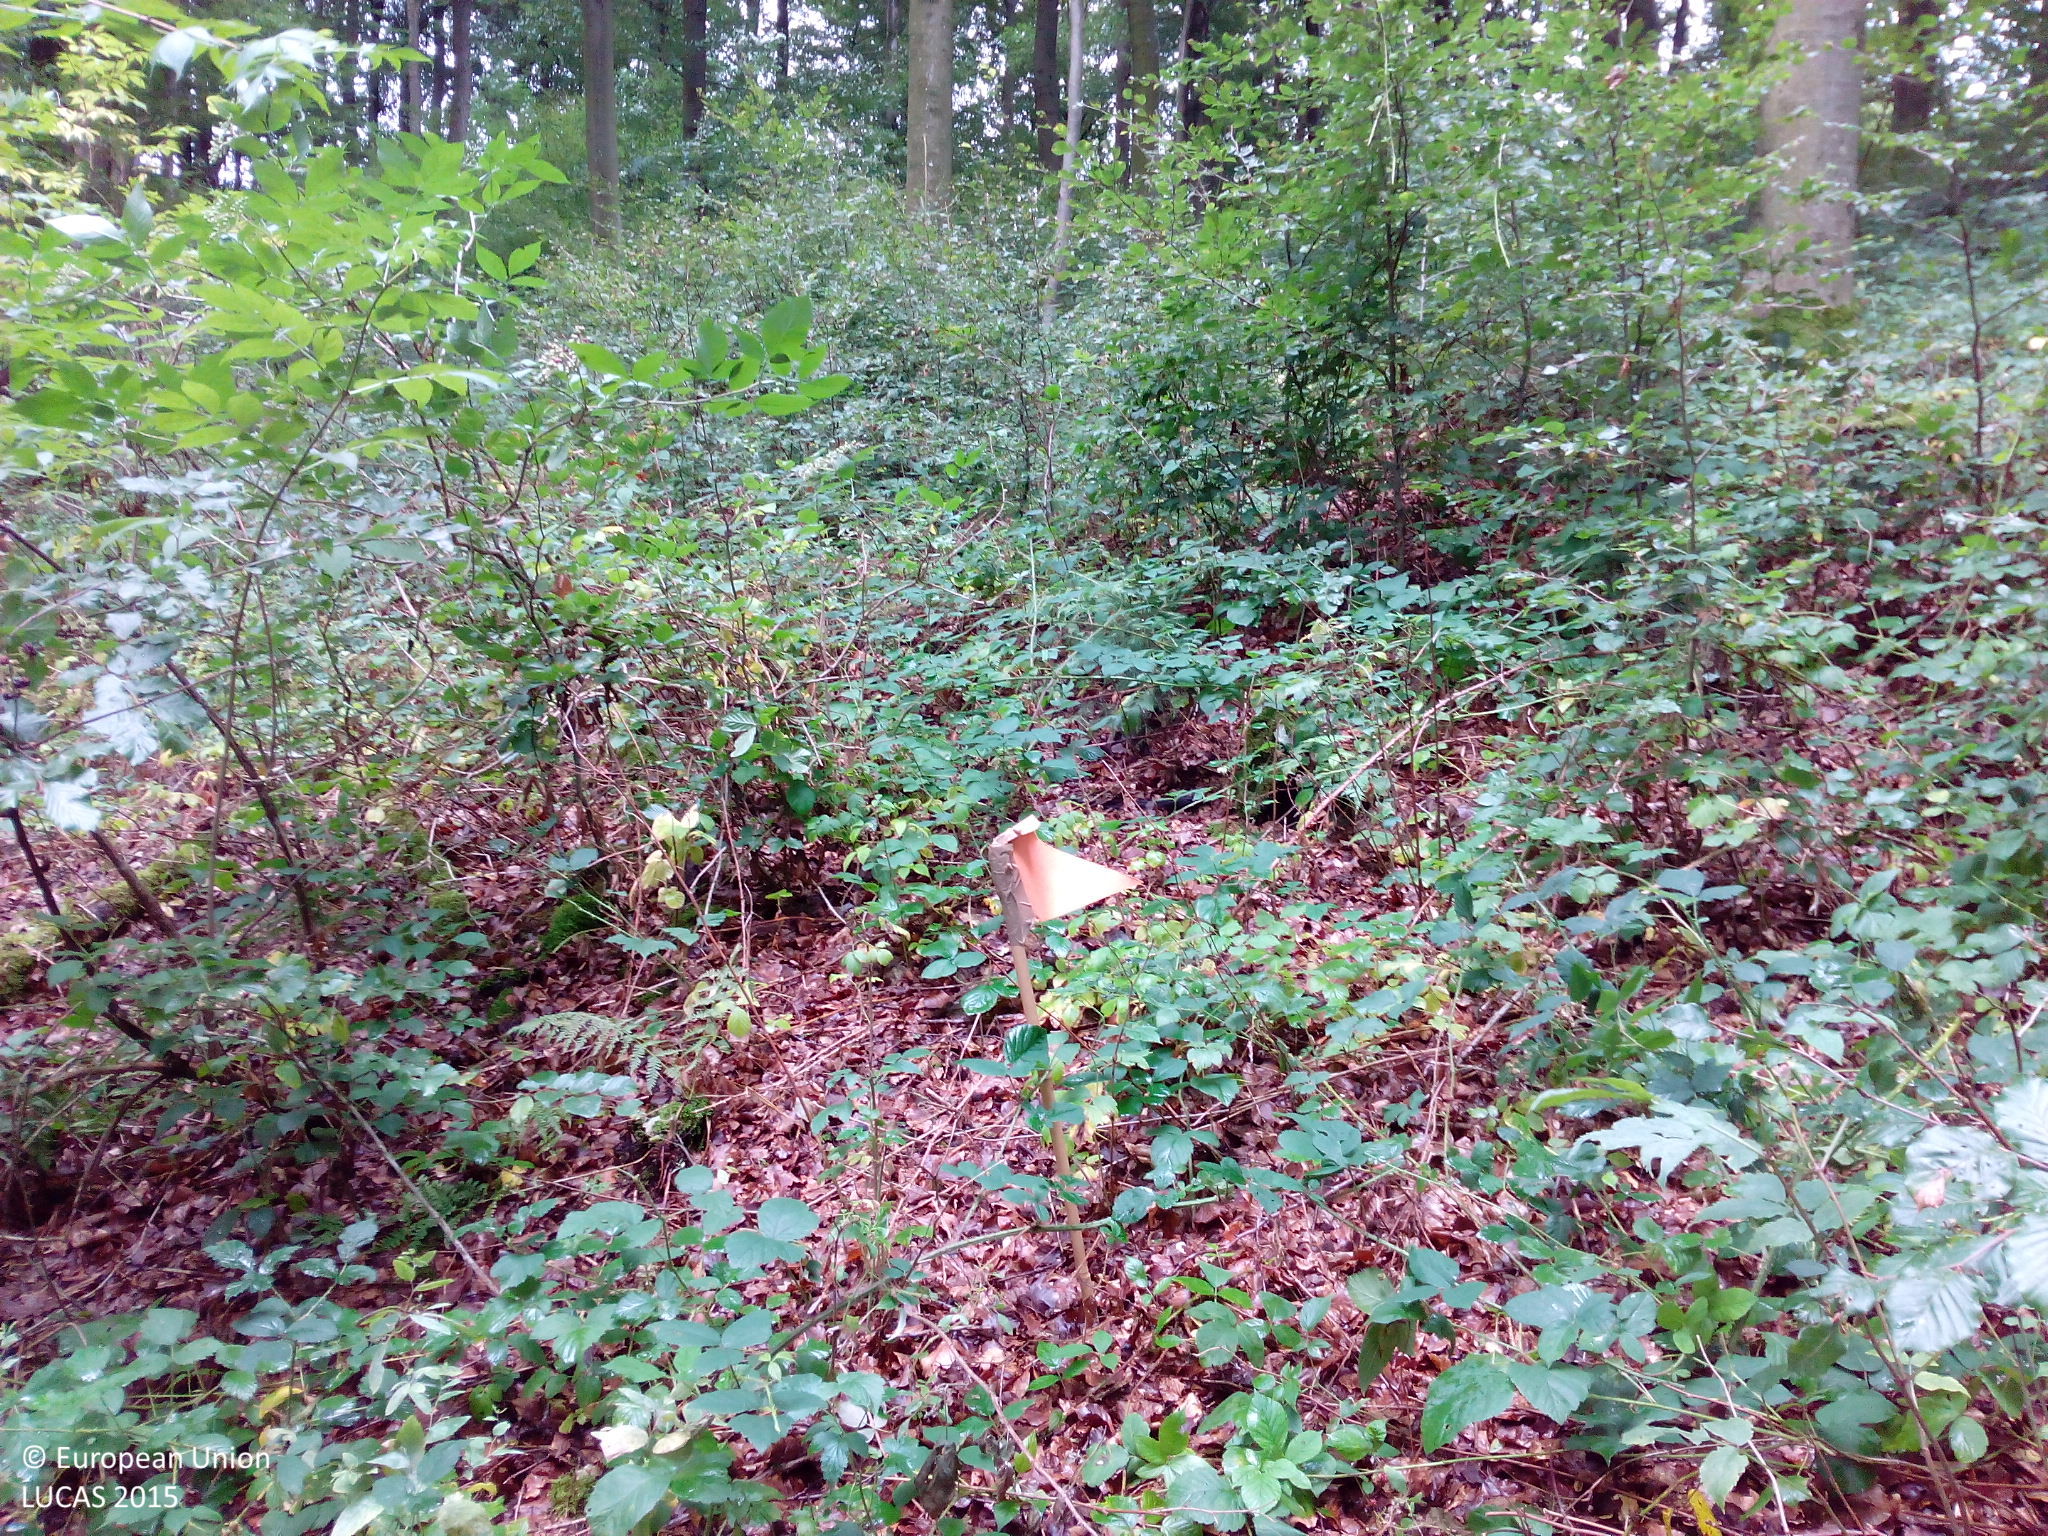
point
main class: Woodland
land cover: Broadleaved woodland
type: beech forest
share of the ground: > 75 %
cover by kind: broadleaved forest trees 100 %
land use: Forestry
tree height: > 5 m
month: August
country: DE
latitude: 50.0163
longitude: 6.3012
